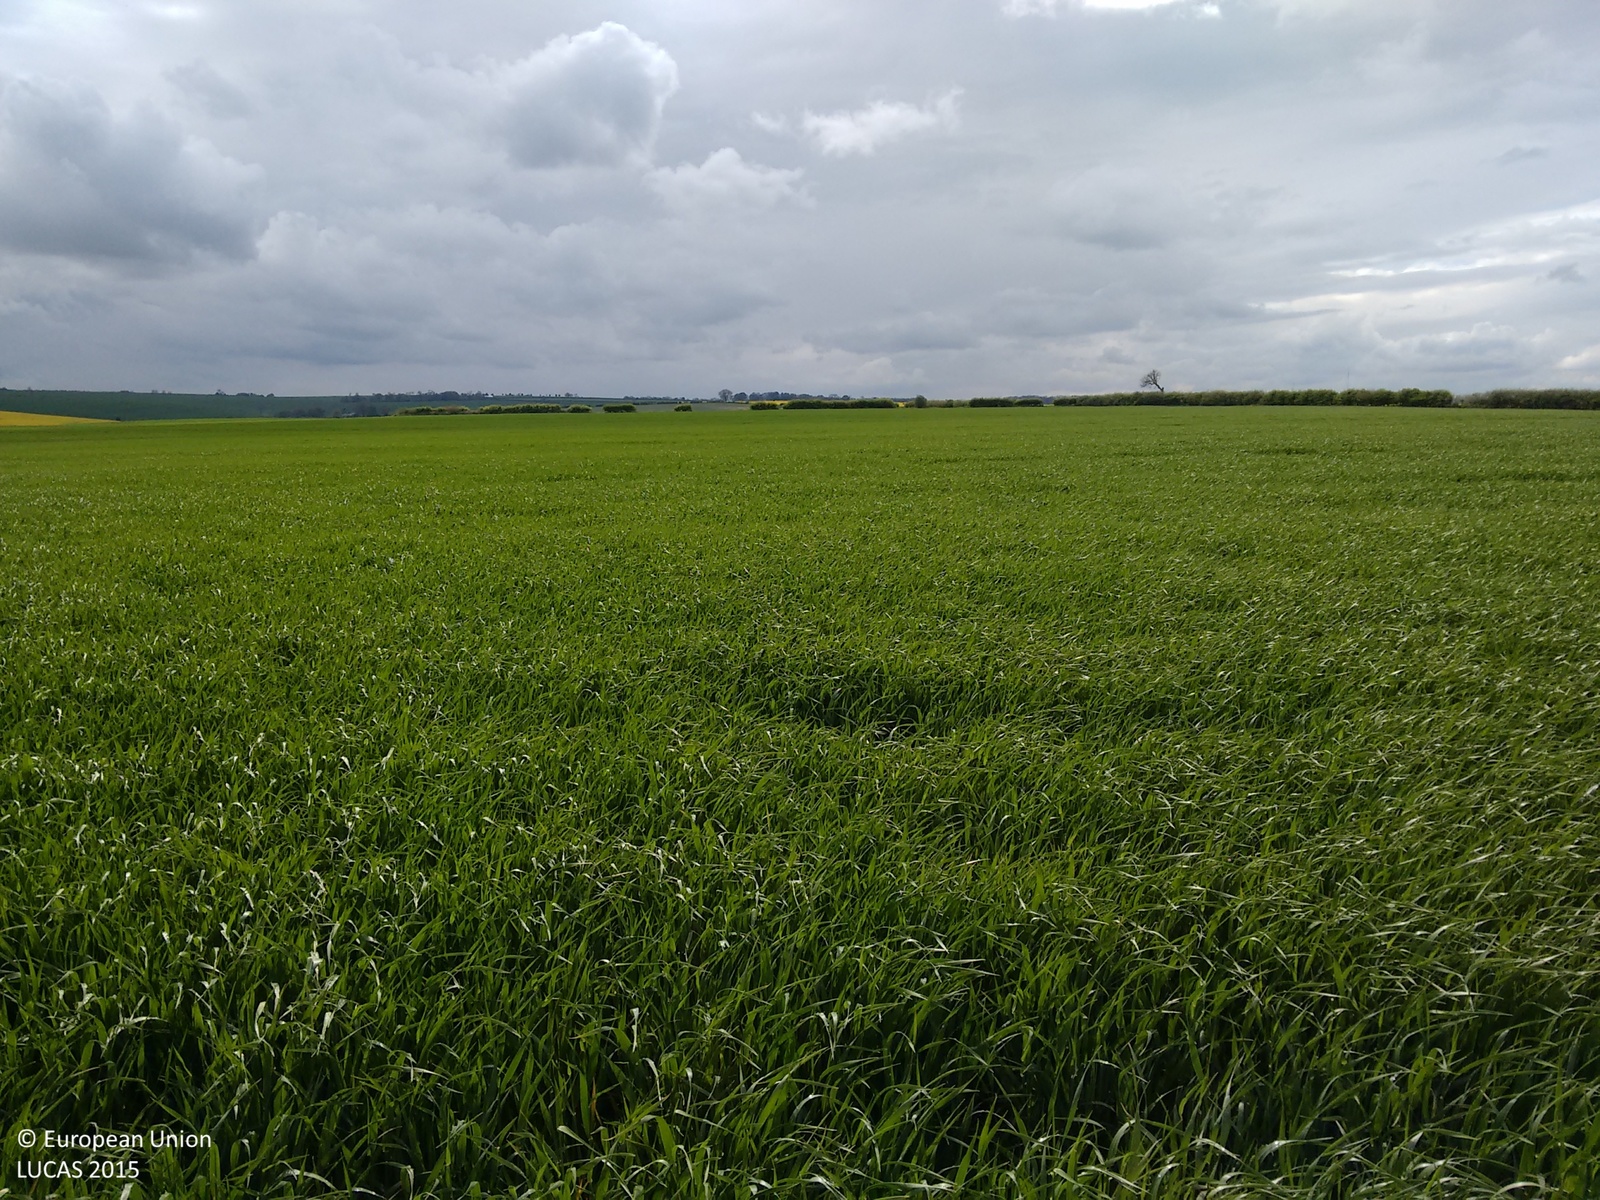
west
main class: Cropland
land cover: Barley
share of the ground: > 75 %
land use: Agriculture (excluding fallow land and kitchen gardens)
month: May
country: GB
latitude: 53.3121
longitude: -0.0131
